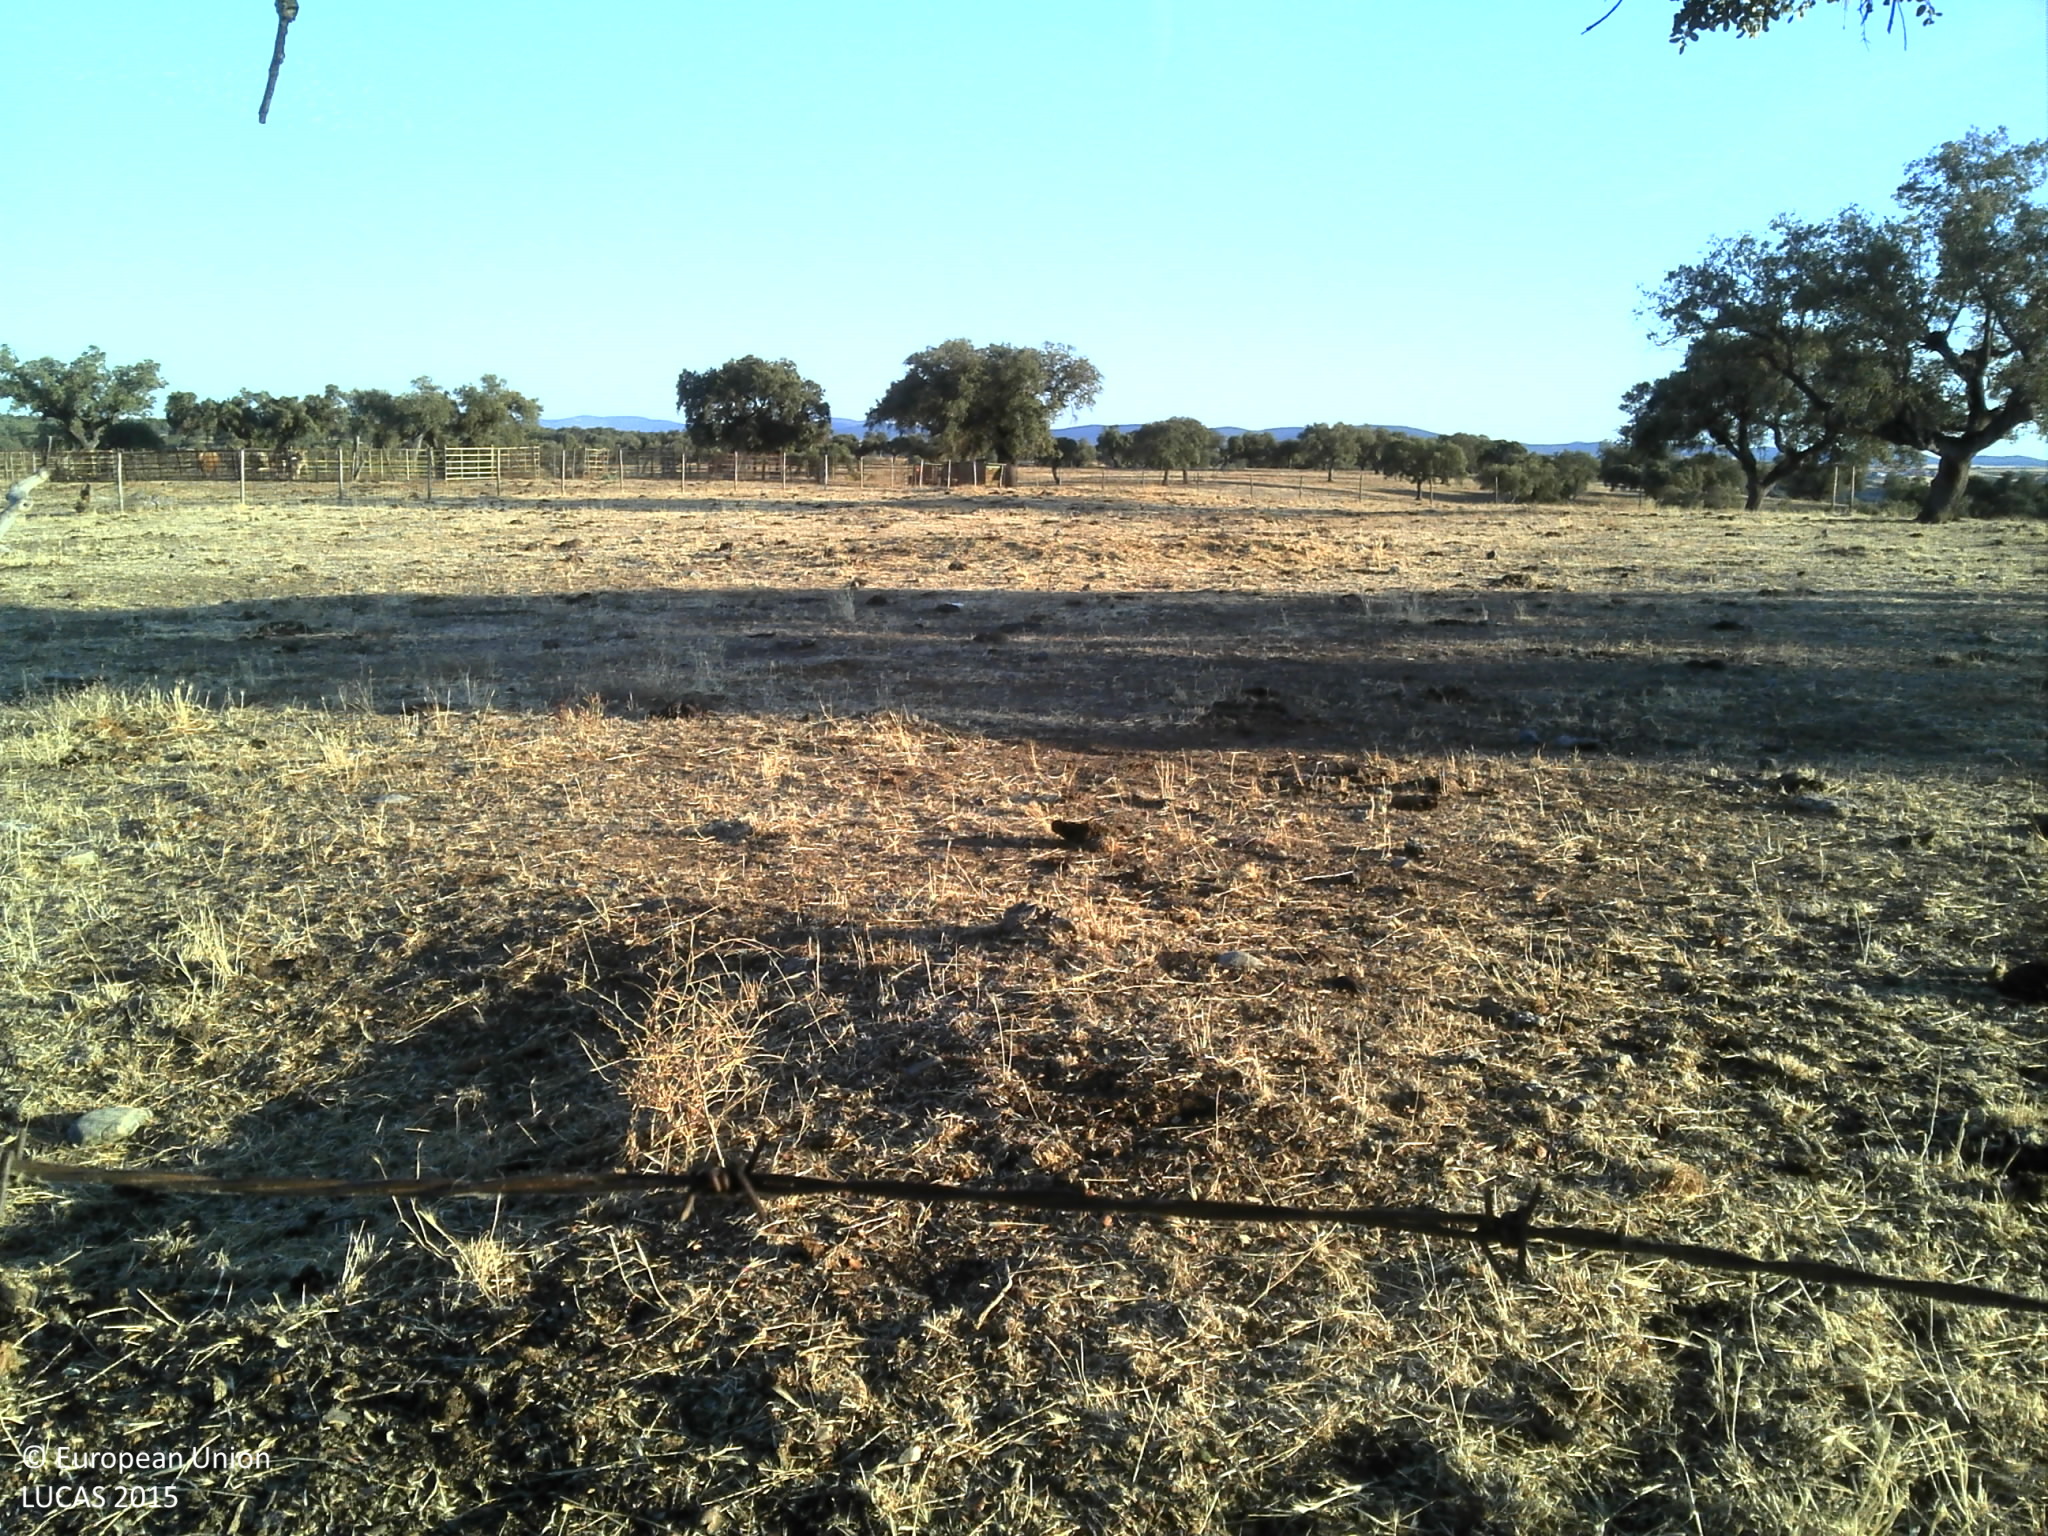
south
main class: Woodland
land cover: Broadleaved woodland
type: broadleaved evergreen forest
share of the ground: 10 - 25 %
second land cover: Grassland without tree/shrub cover
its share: 10 - 25 %
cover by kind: unconsolidated bare surface 70 %, broadleaved forest trees 15 %, herbaceous plants 15 %
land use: Forestry
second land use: Agriculture (excluding fallow land and kitchen gardens)
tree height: > 5 m
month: July
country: PT
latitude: 38.1658
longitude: -7.2866
